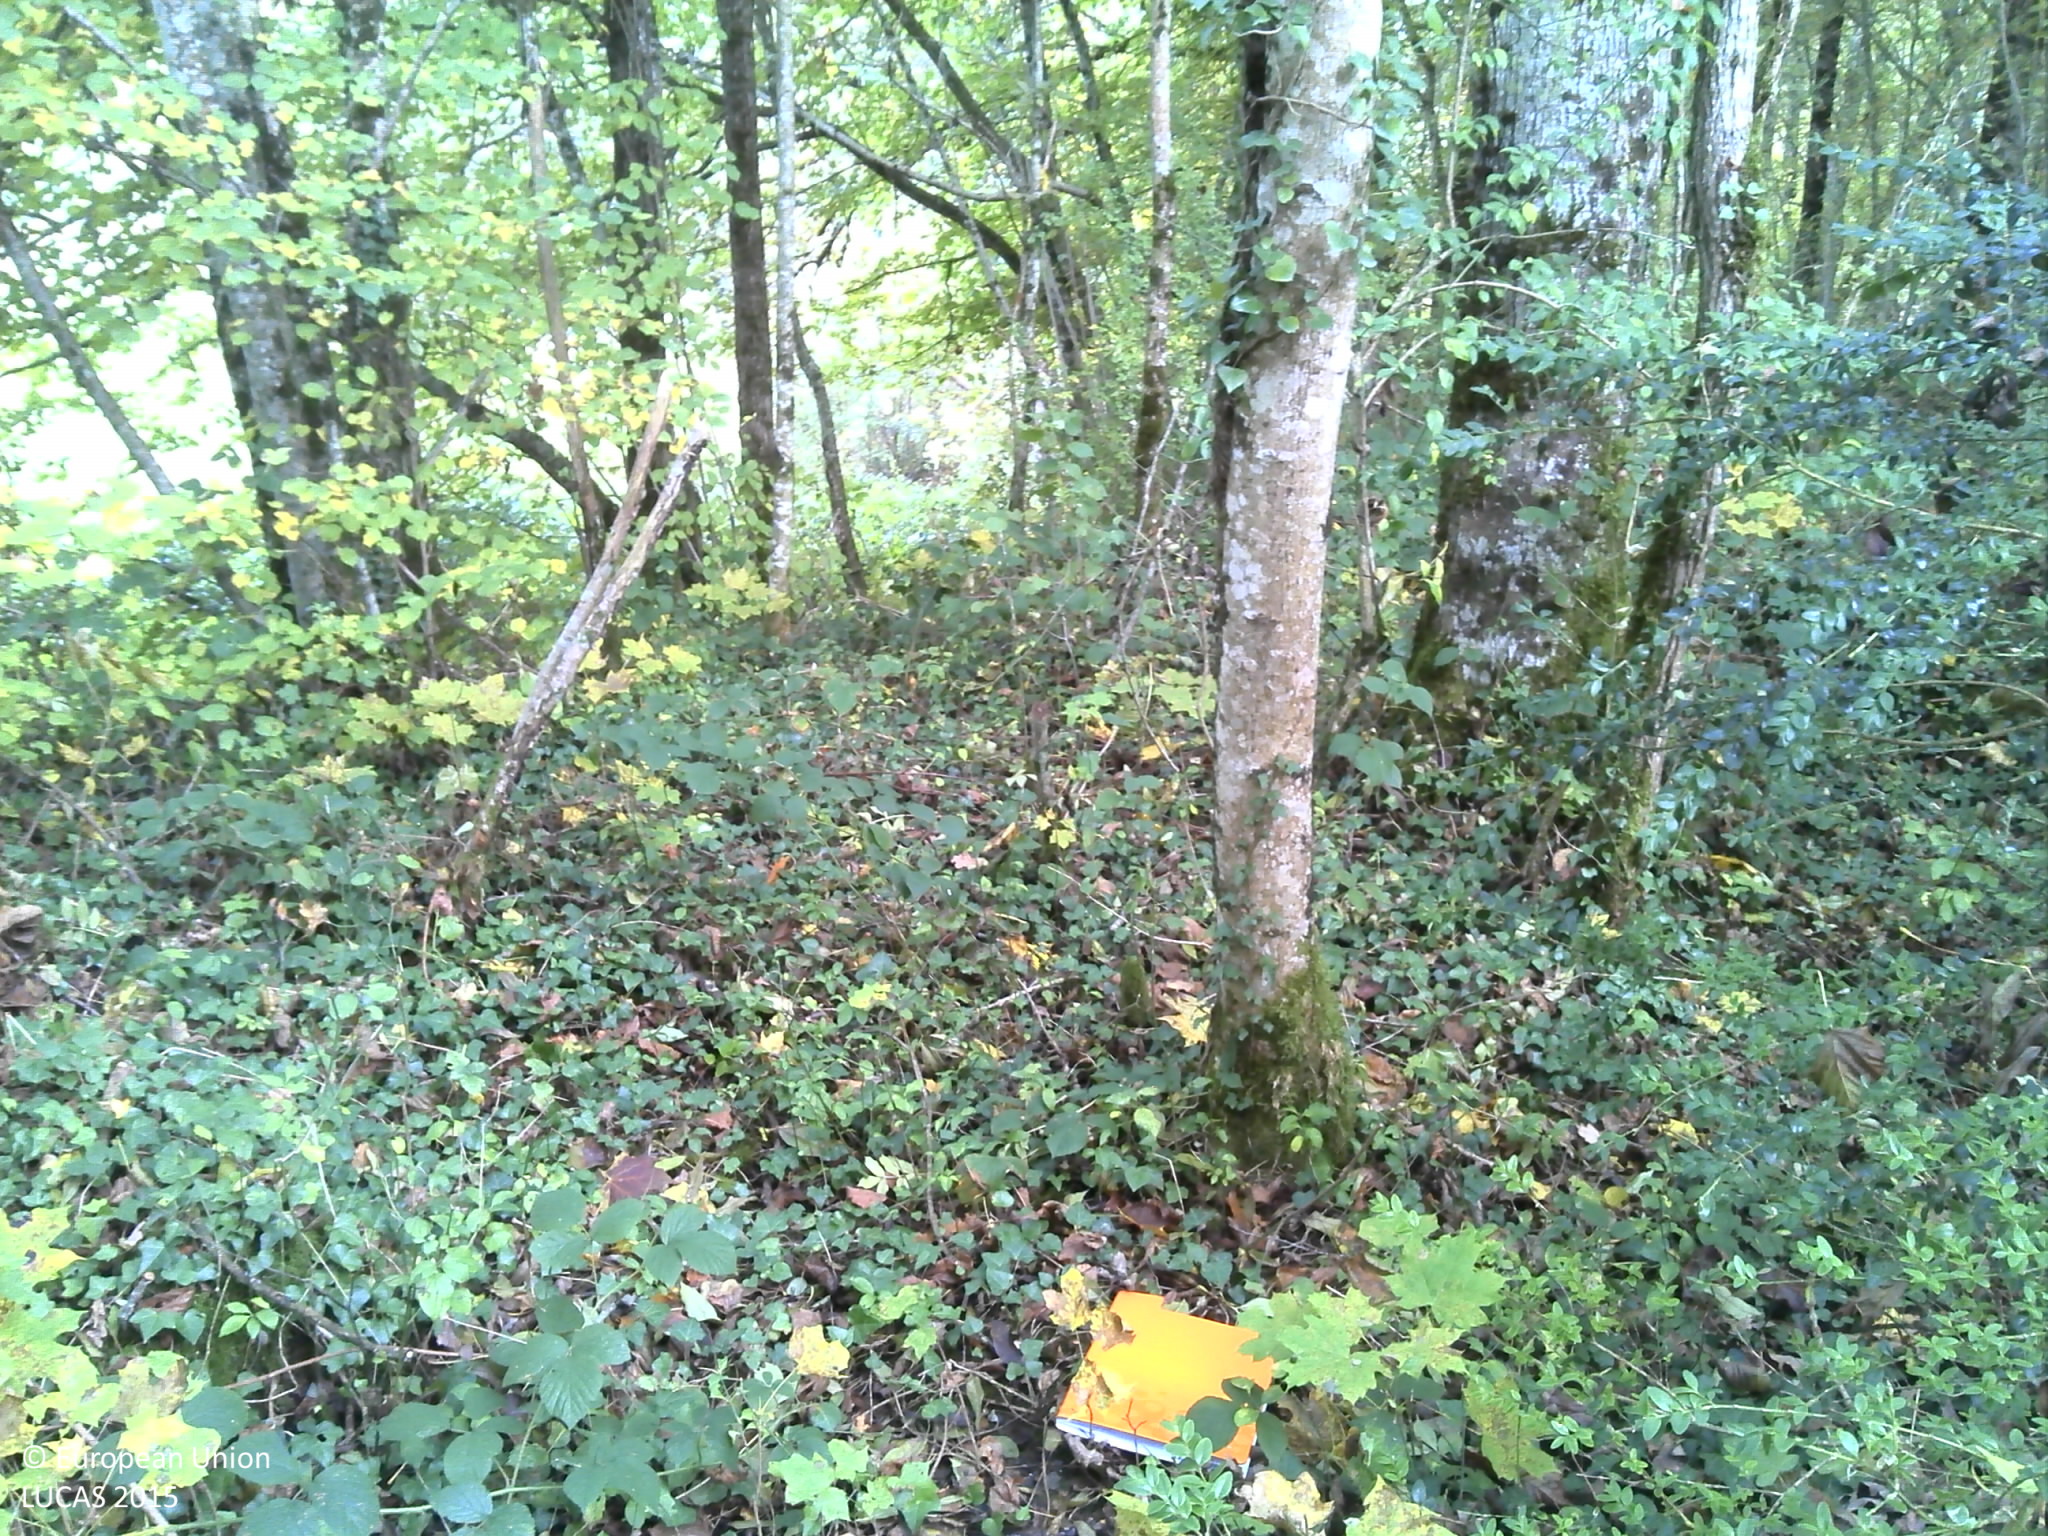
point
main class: Woodland
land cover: Broadleaved woodland
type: mesophytic deciduous forest
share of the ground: > 75 %
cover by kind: broadleaved forest trees 90 %, shrubs 5 %, herbaceous plants 5 %
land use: Forestry
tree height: > 5 m
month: October
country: FR
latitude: 46.0882
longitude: 5.3604
